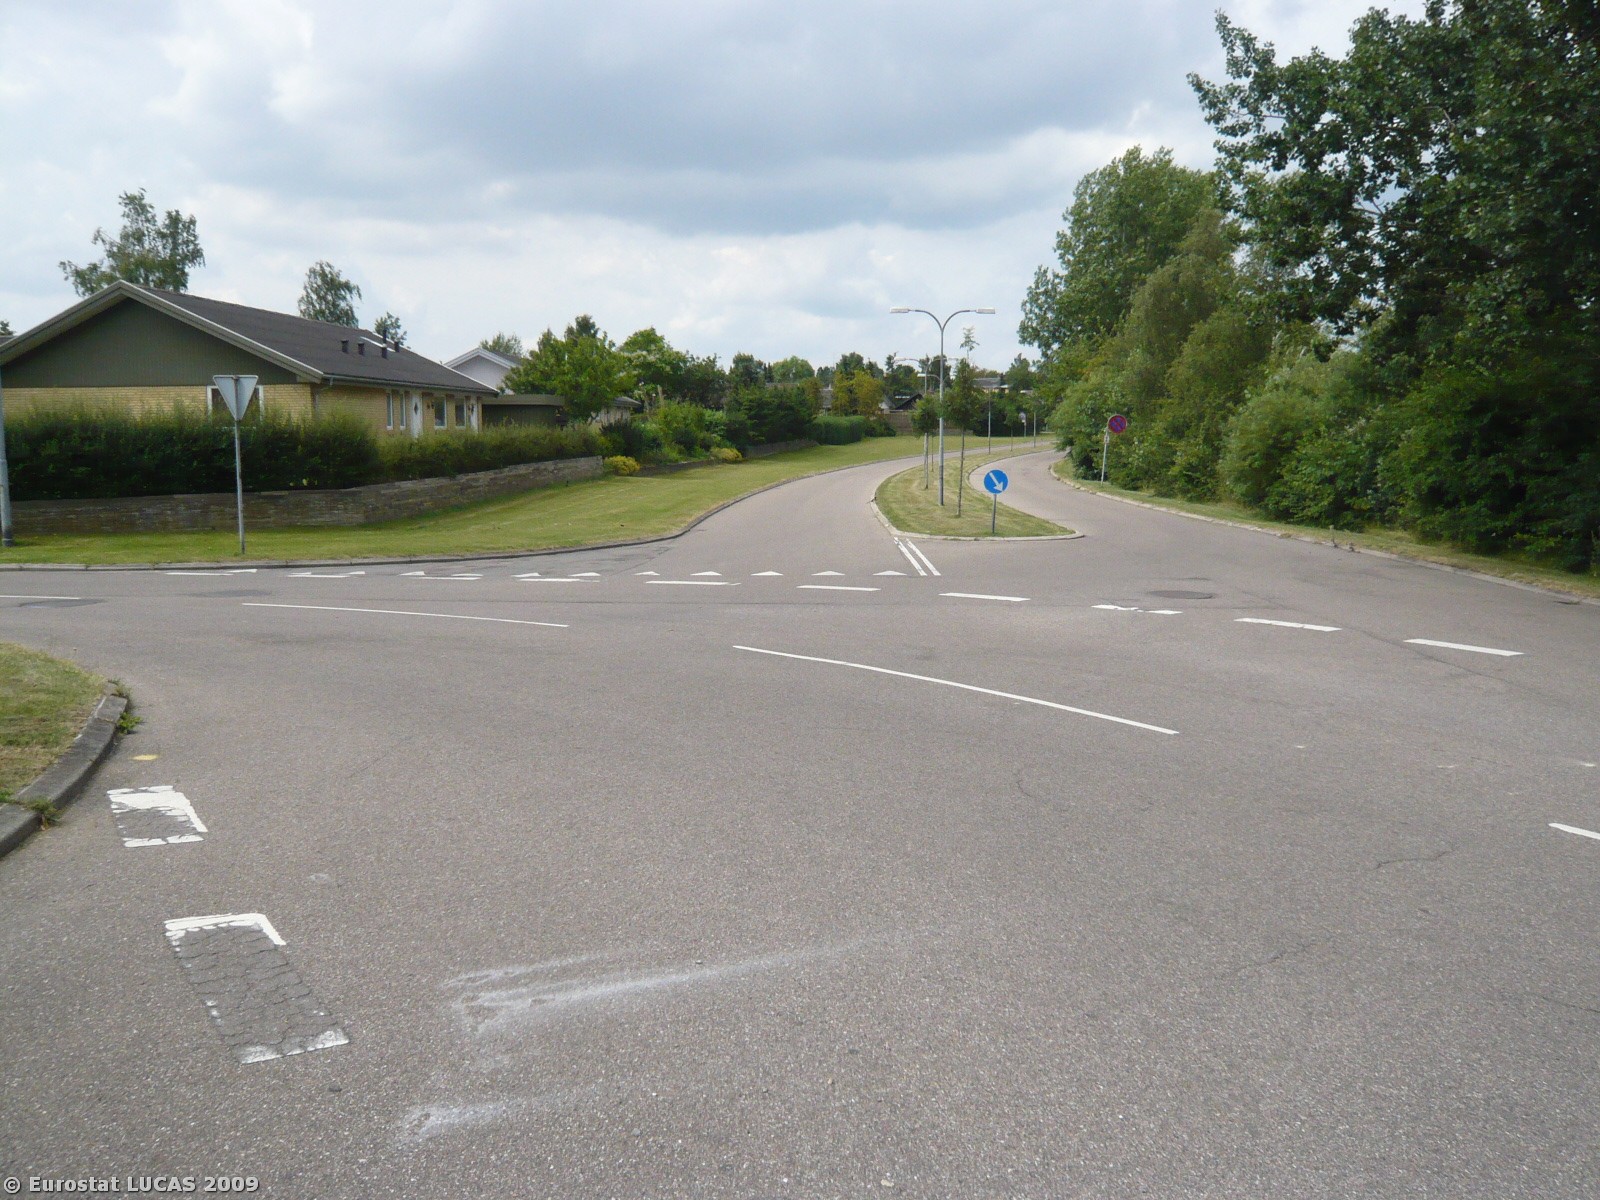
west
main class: Grassland
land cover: Grassland without tree/shrub cover
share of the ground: > 75 %
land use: Residential
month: July
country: DK
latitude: 55.8291
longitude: 12.0894
